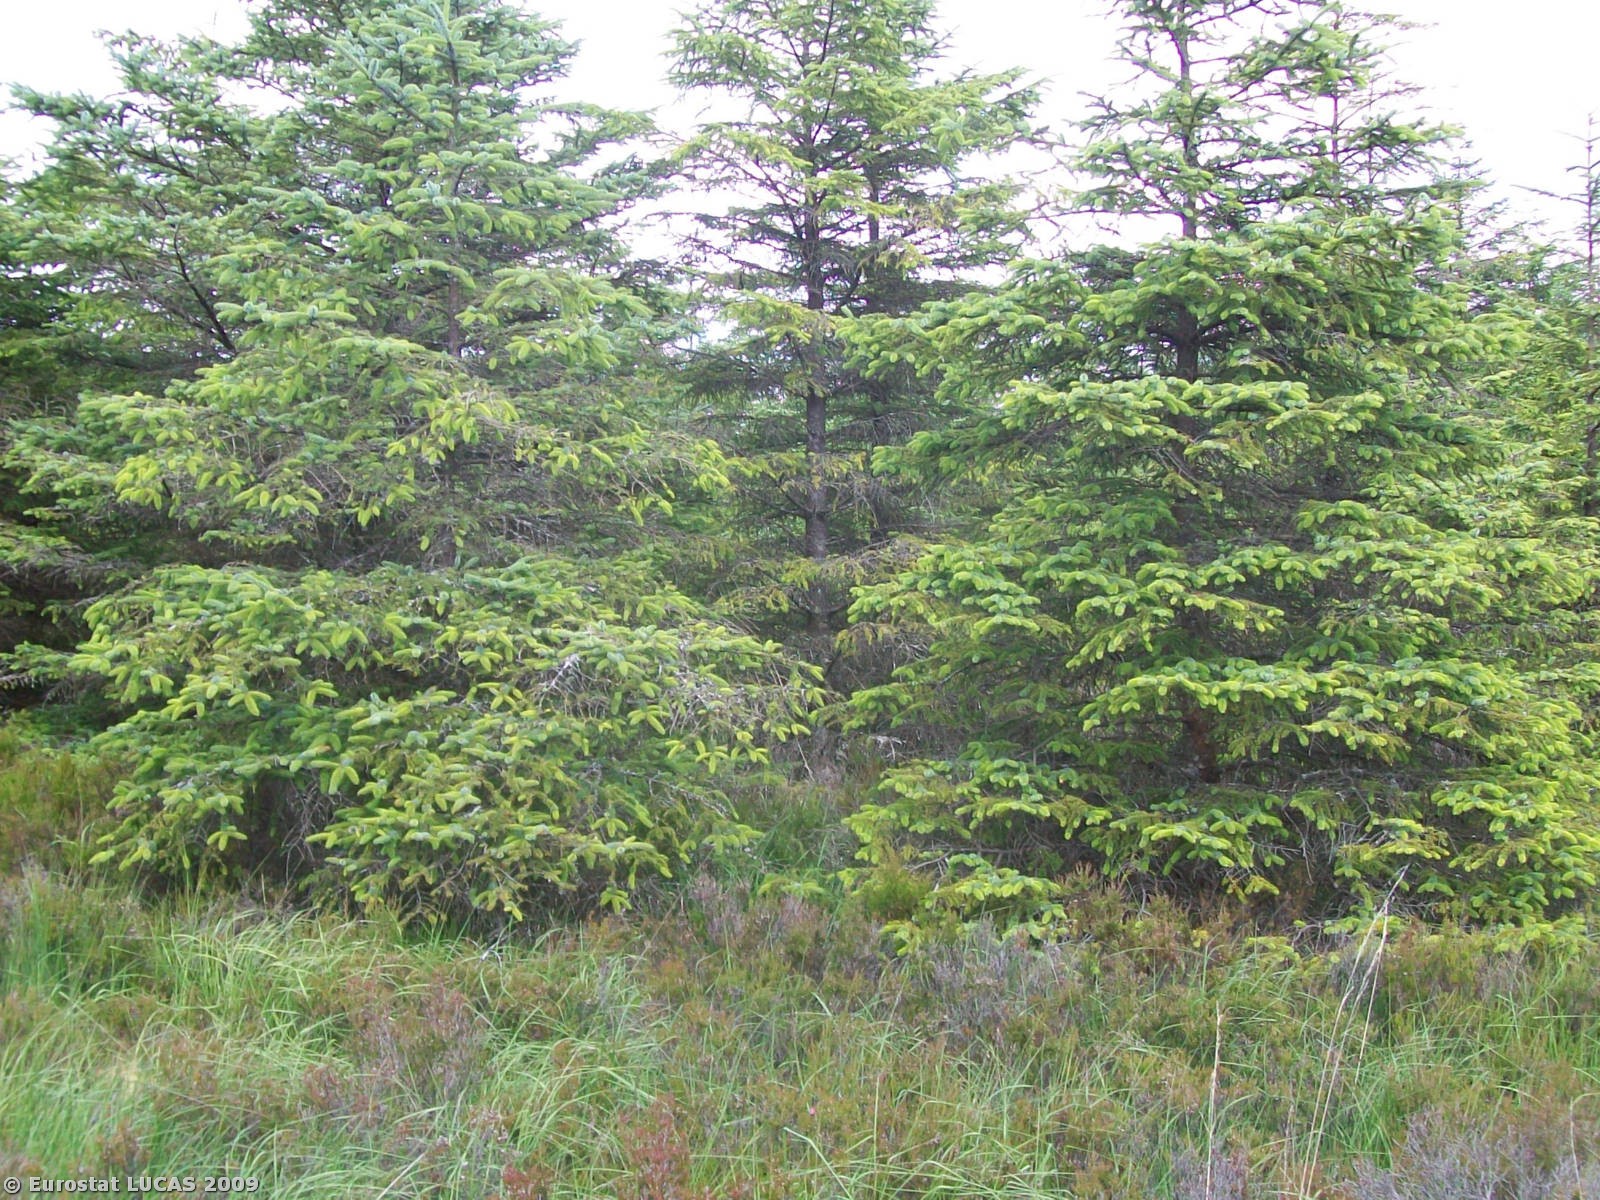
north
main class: Woodland
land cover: Coniferous woodland
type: plantations and self-sown exotic forest
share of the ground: > 75 %
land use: Forestry
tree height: > 5 m
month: July
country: IE
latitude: 54.0942
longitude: -8.9077
